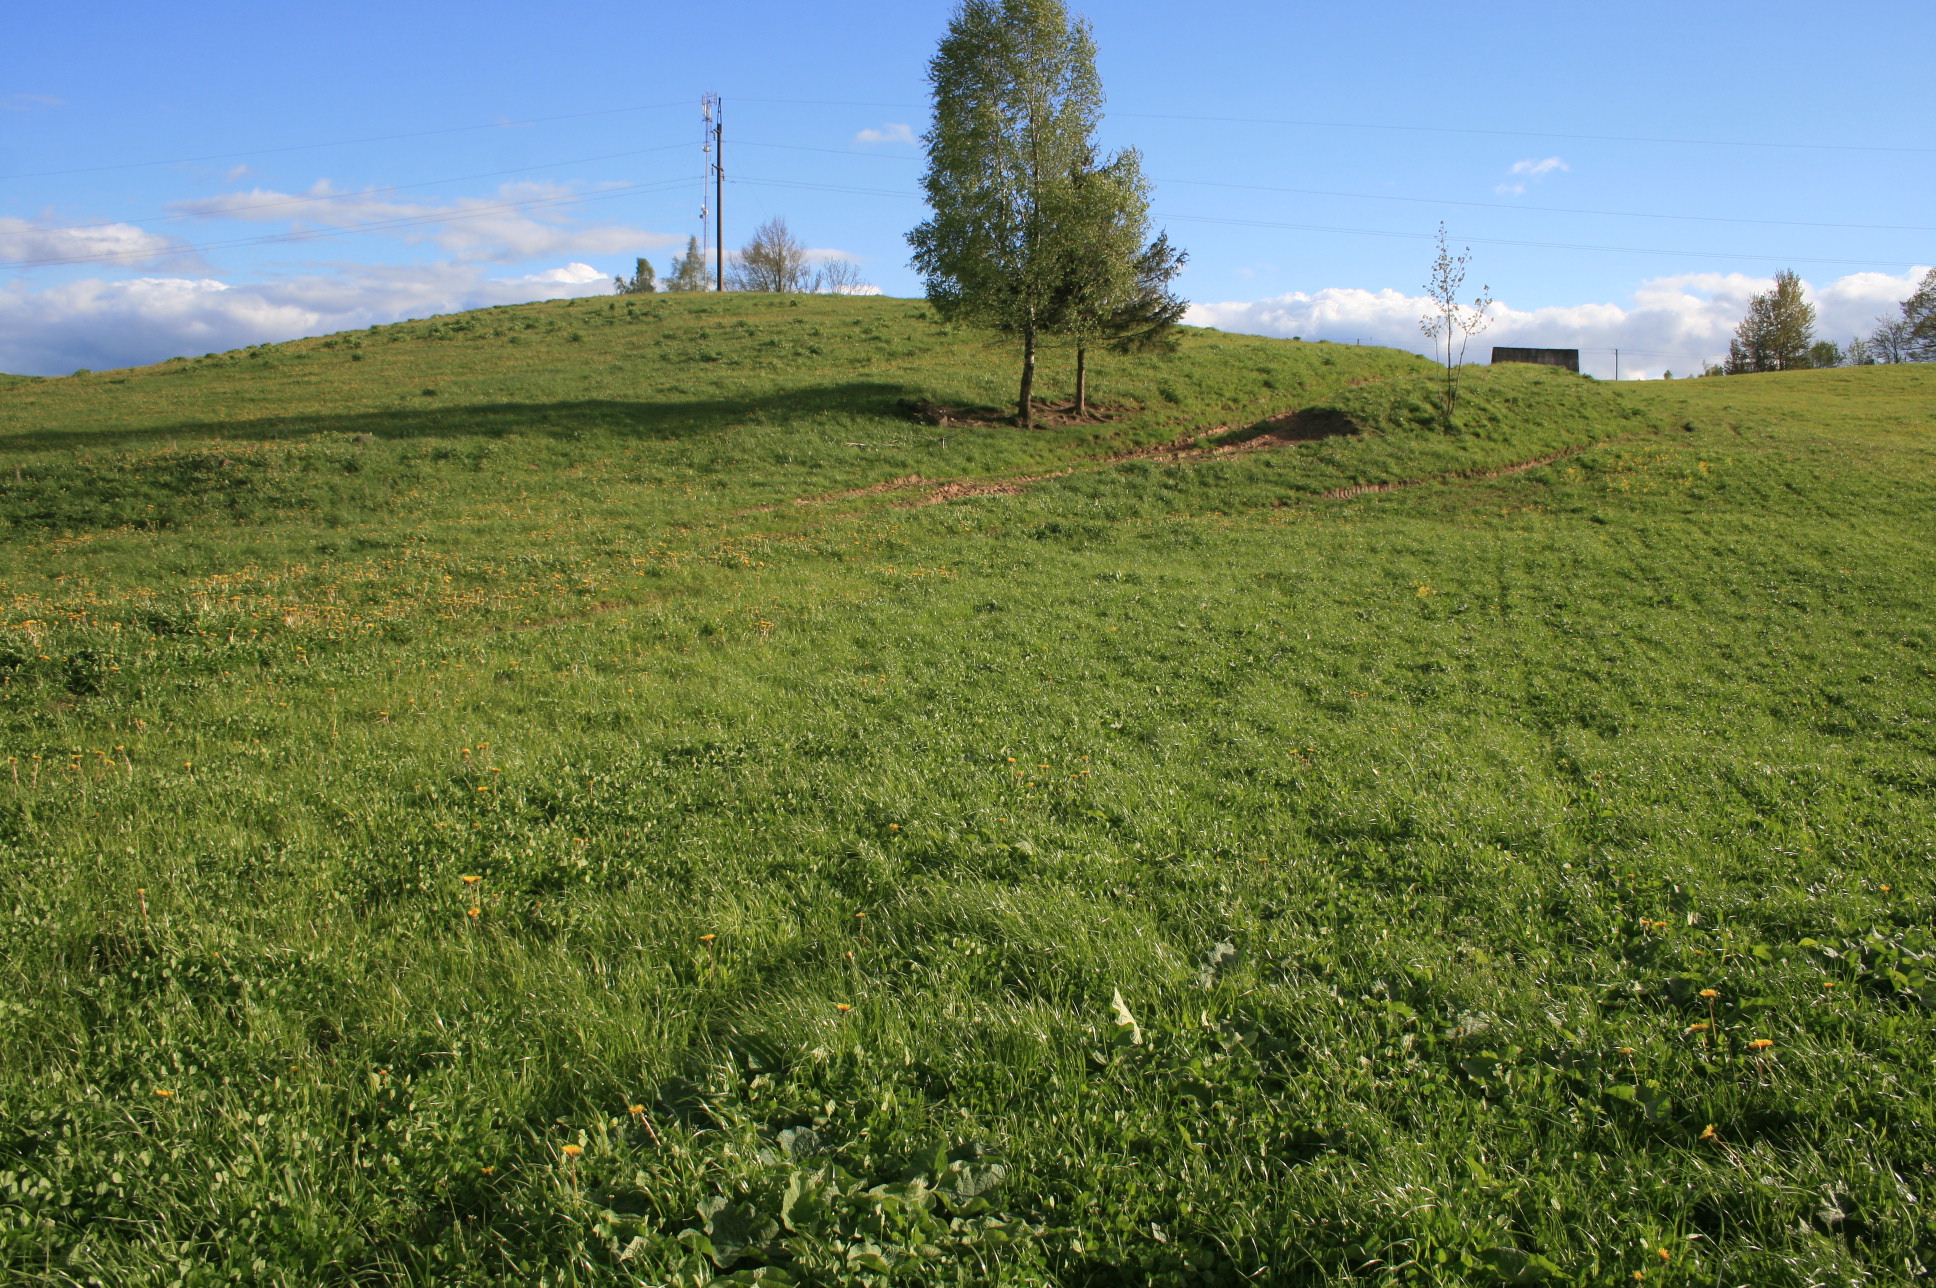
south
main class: Grassland
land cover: Grassland without tree/shrub cover
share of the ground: > 75 %
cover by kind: herbaceous plants 100 %
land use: Agriculture (excluding fallow land and kitchen gardens)
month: May
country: LT
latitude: 56.0576
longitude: 22.0150
